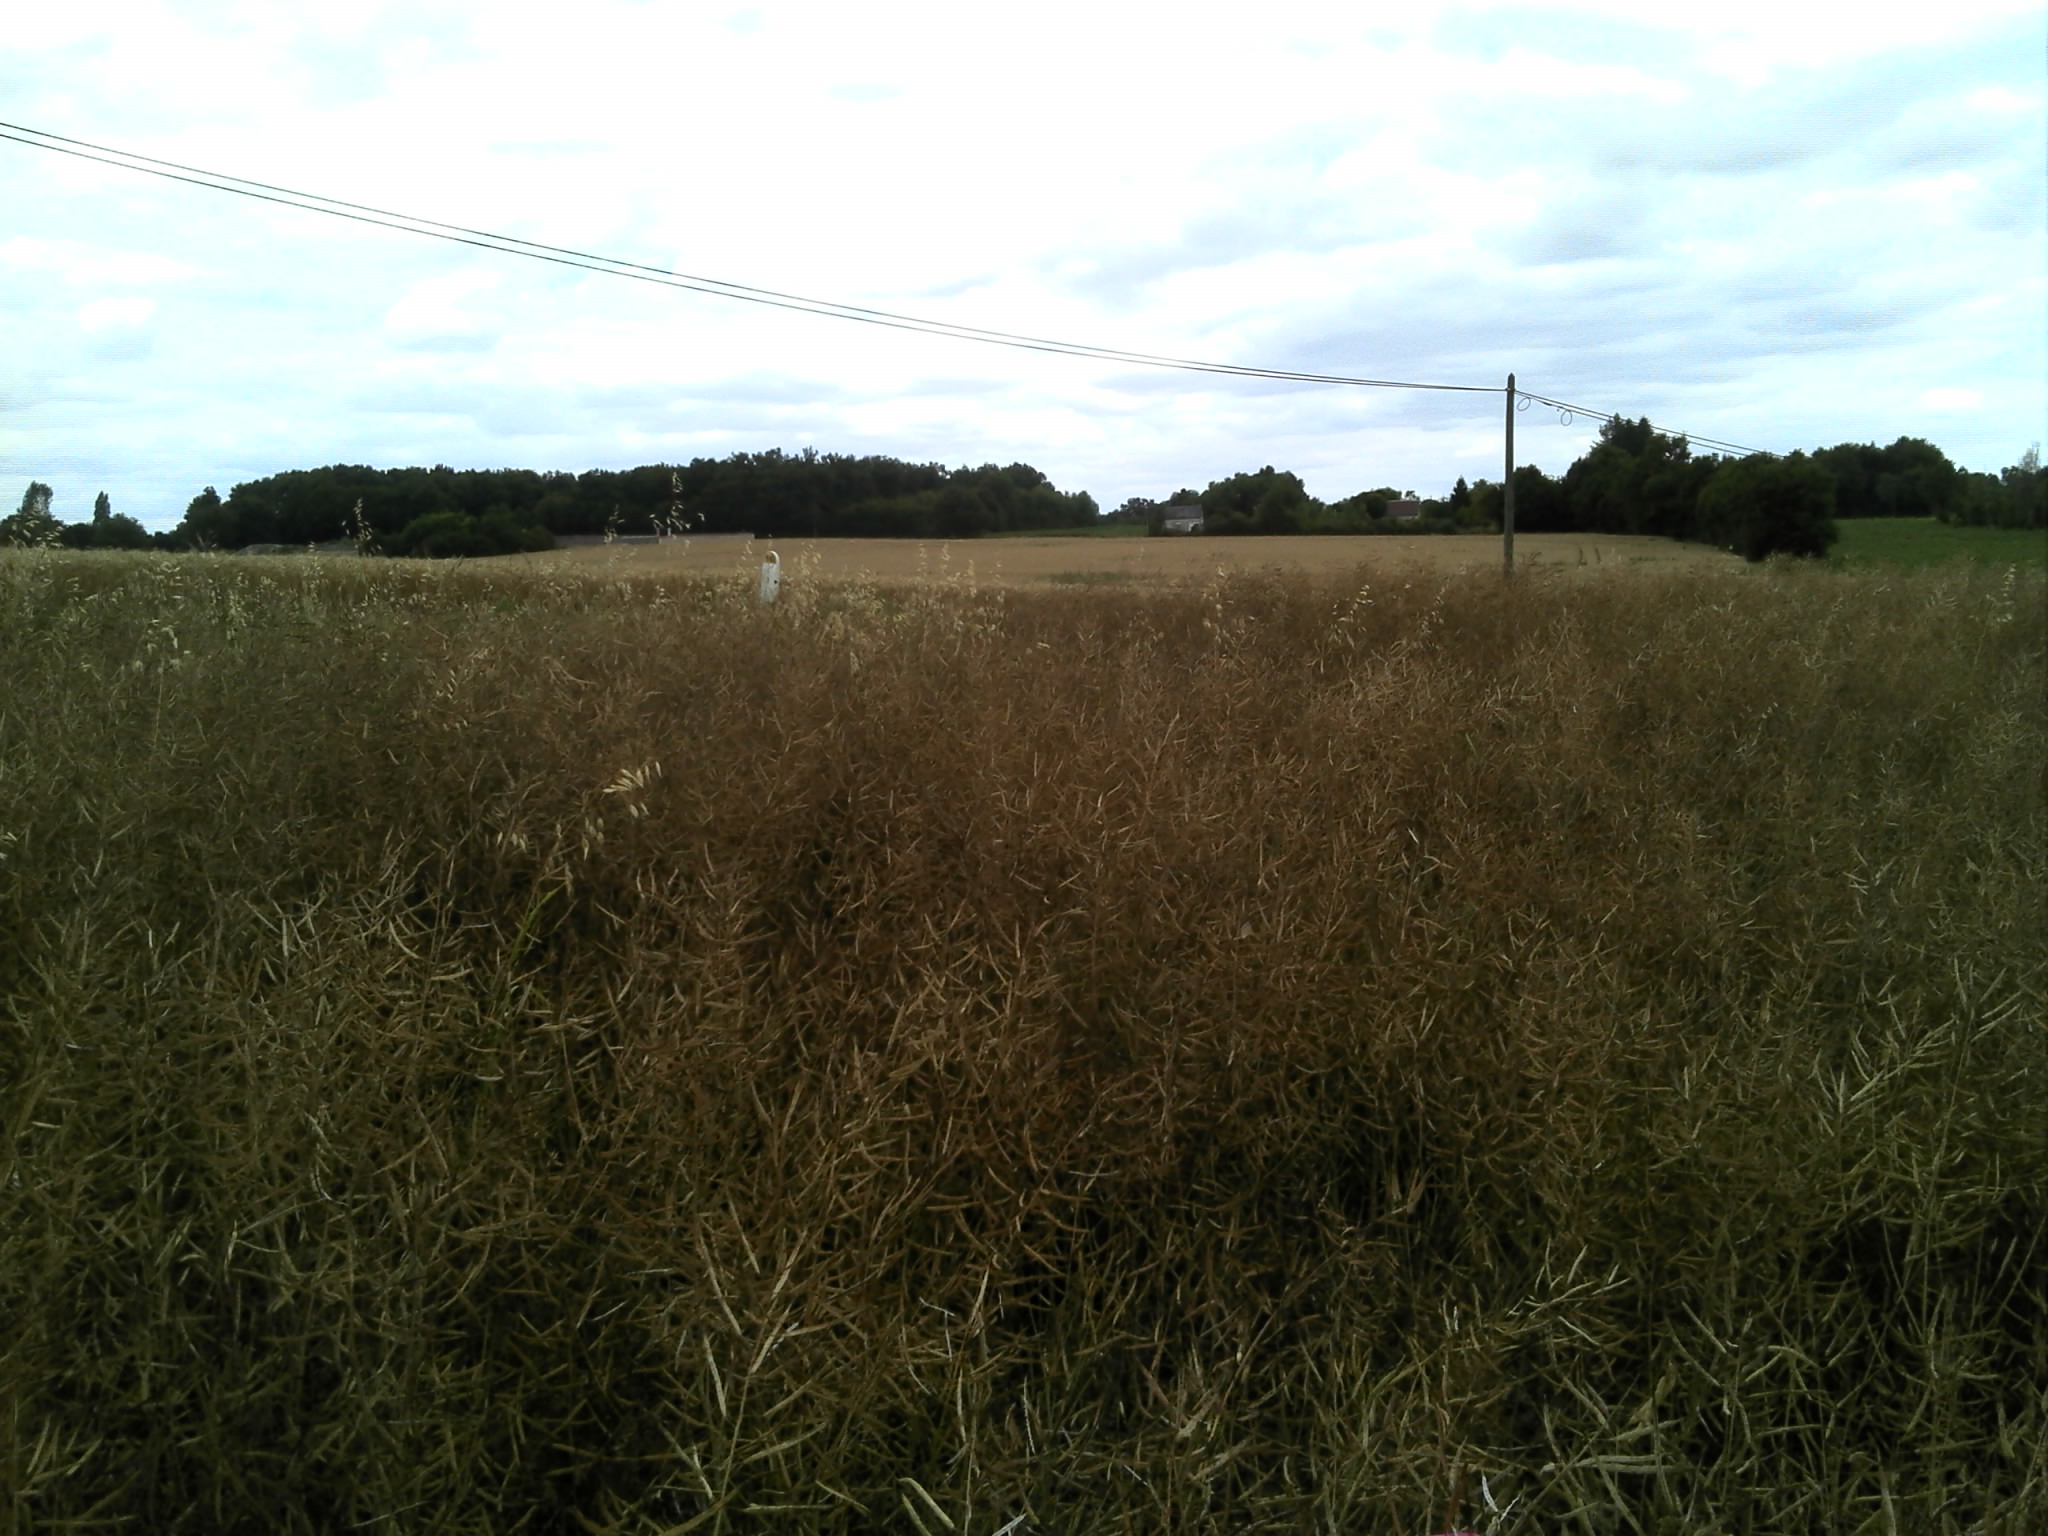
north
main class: Cropland
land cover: Rape and turnip rape
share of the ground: > 75 %
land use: Agriculture (excluding fallow land and kitchen gardens)
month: July
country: FR
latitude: 46.9211
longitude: 1.0951
